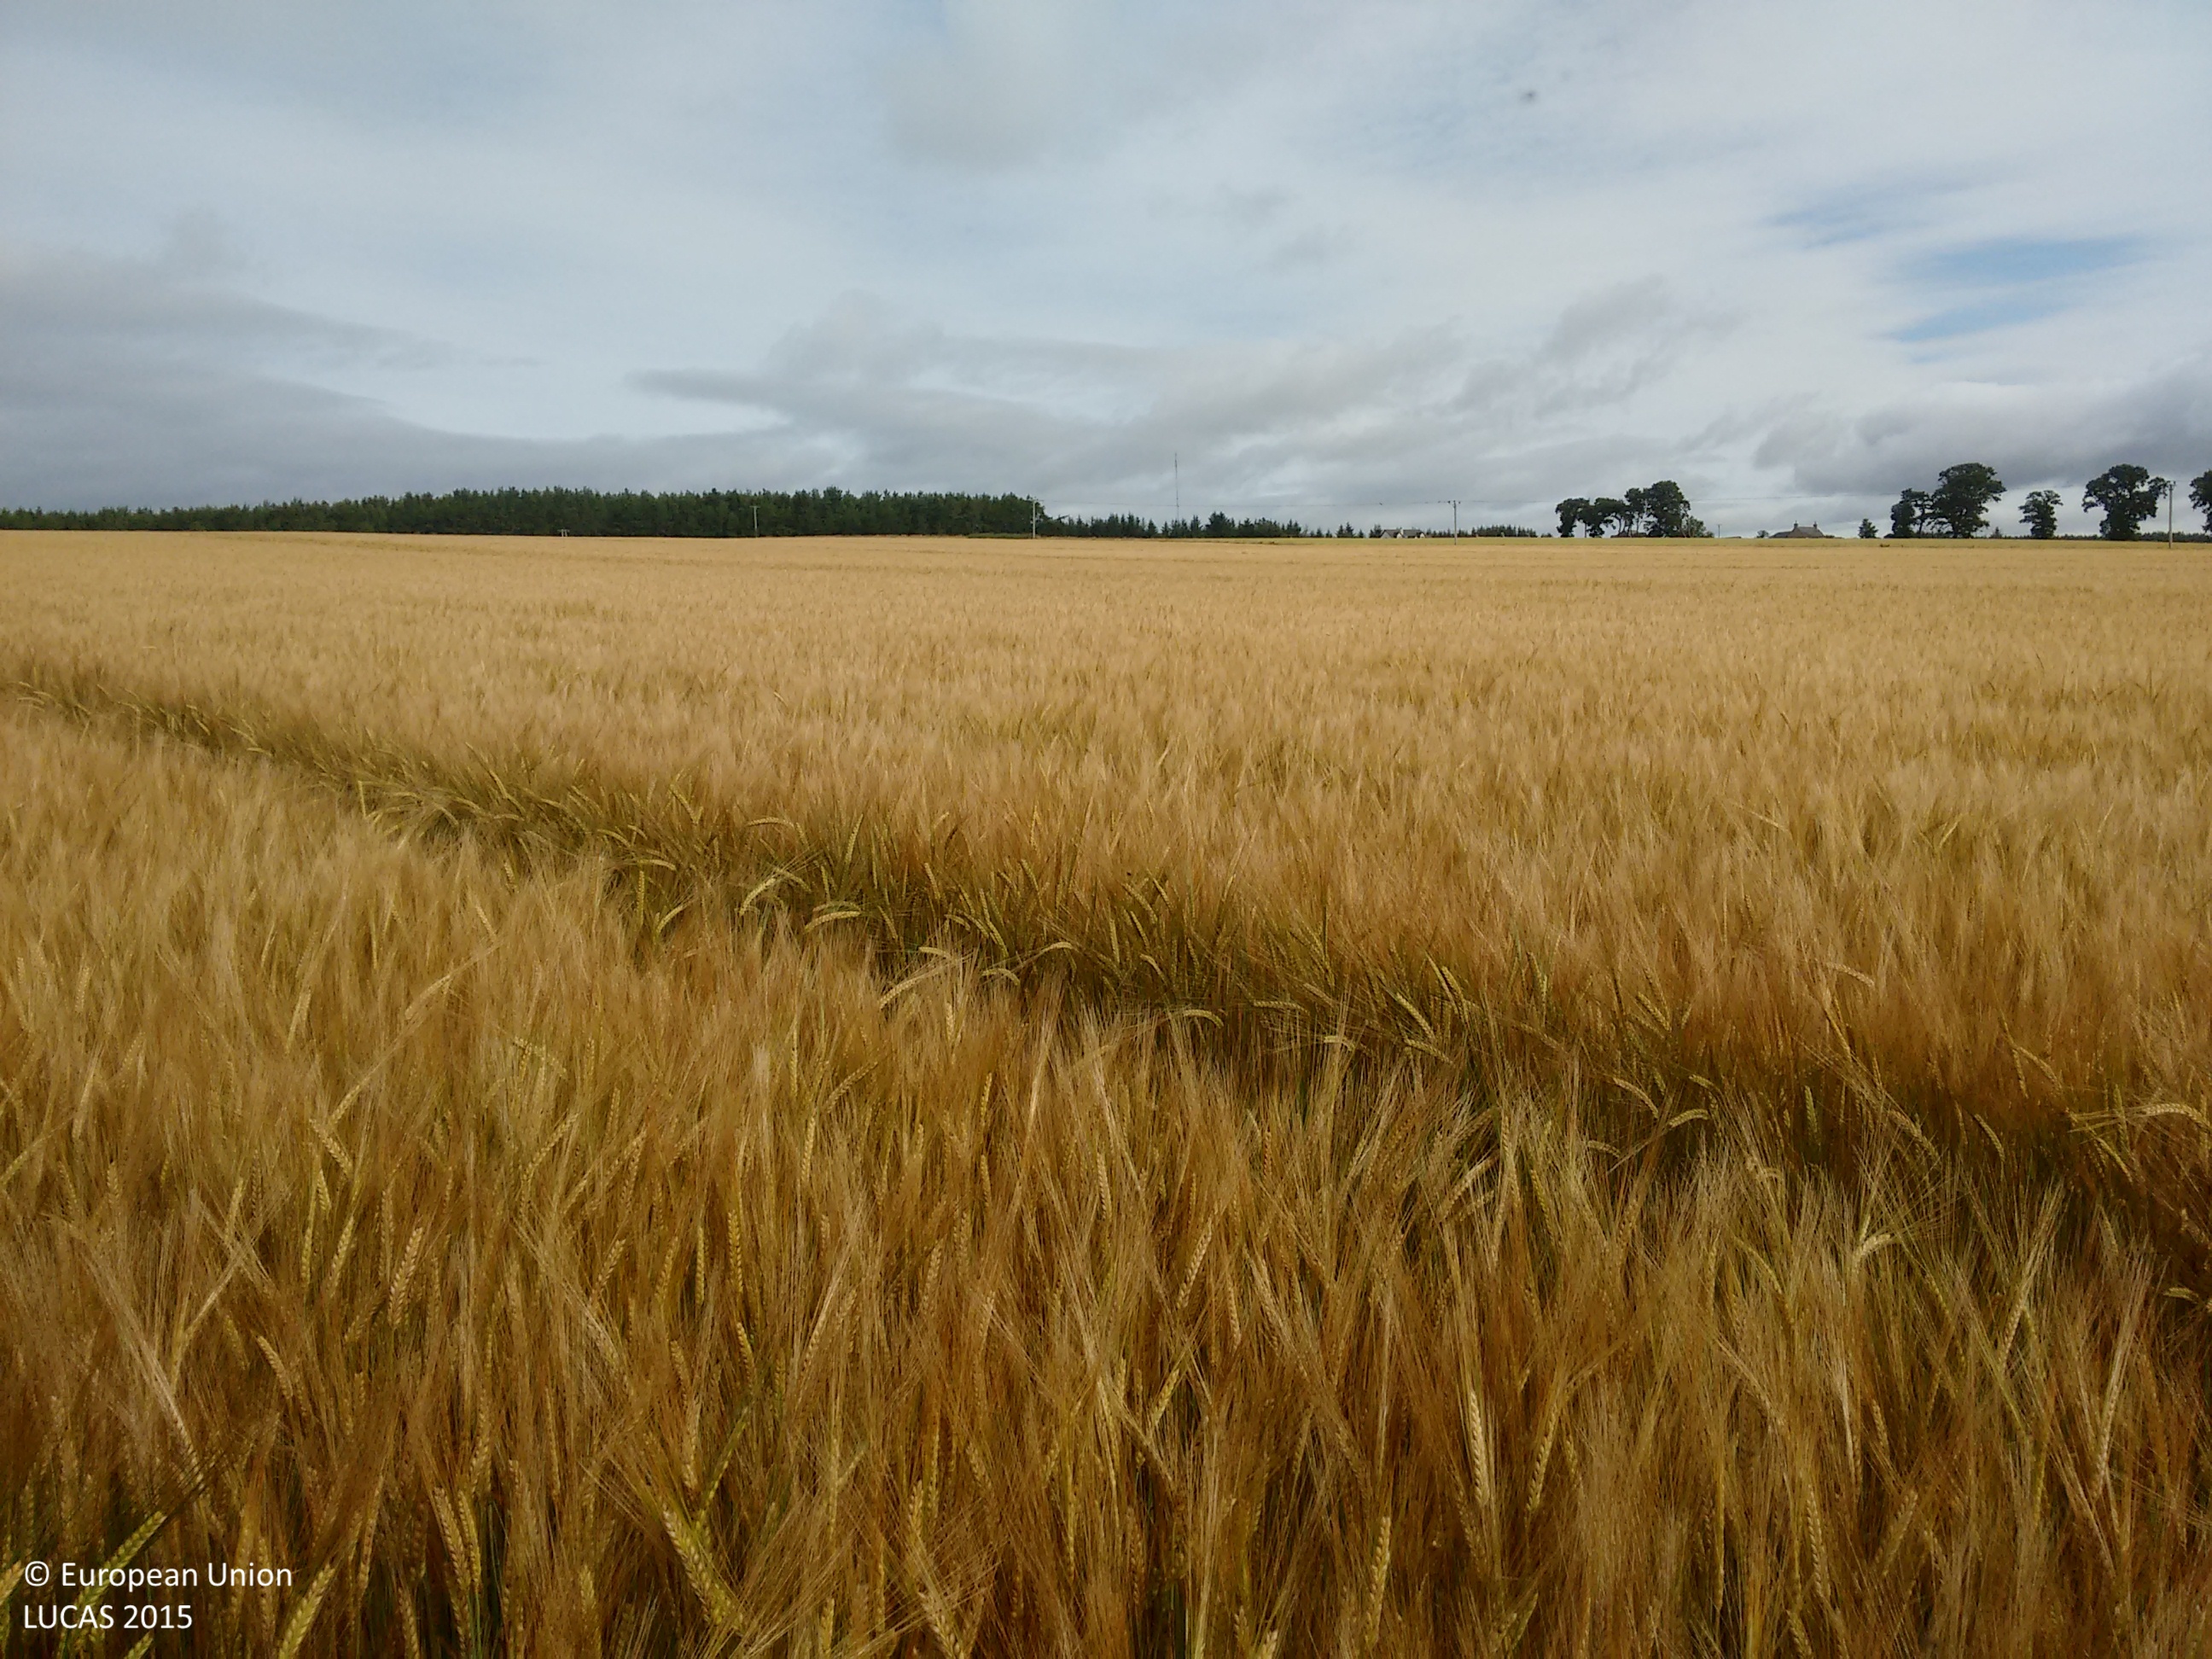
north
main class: Cropland
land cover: Barley
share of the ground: > 75 %
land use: Agriculture (excluding fallow land and kitchen gardens)
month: August
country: GB
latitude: 57.5615
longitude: -4.2771
